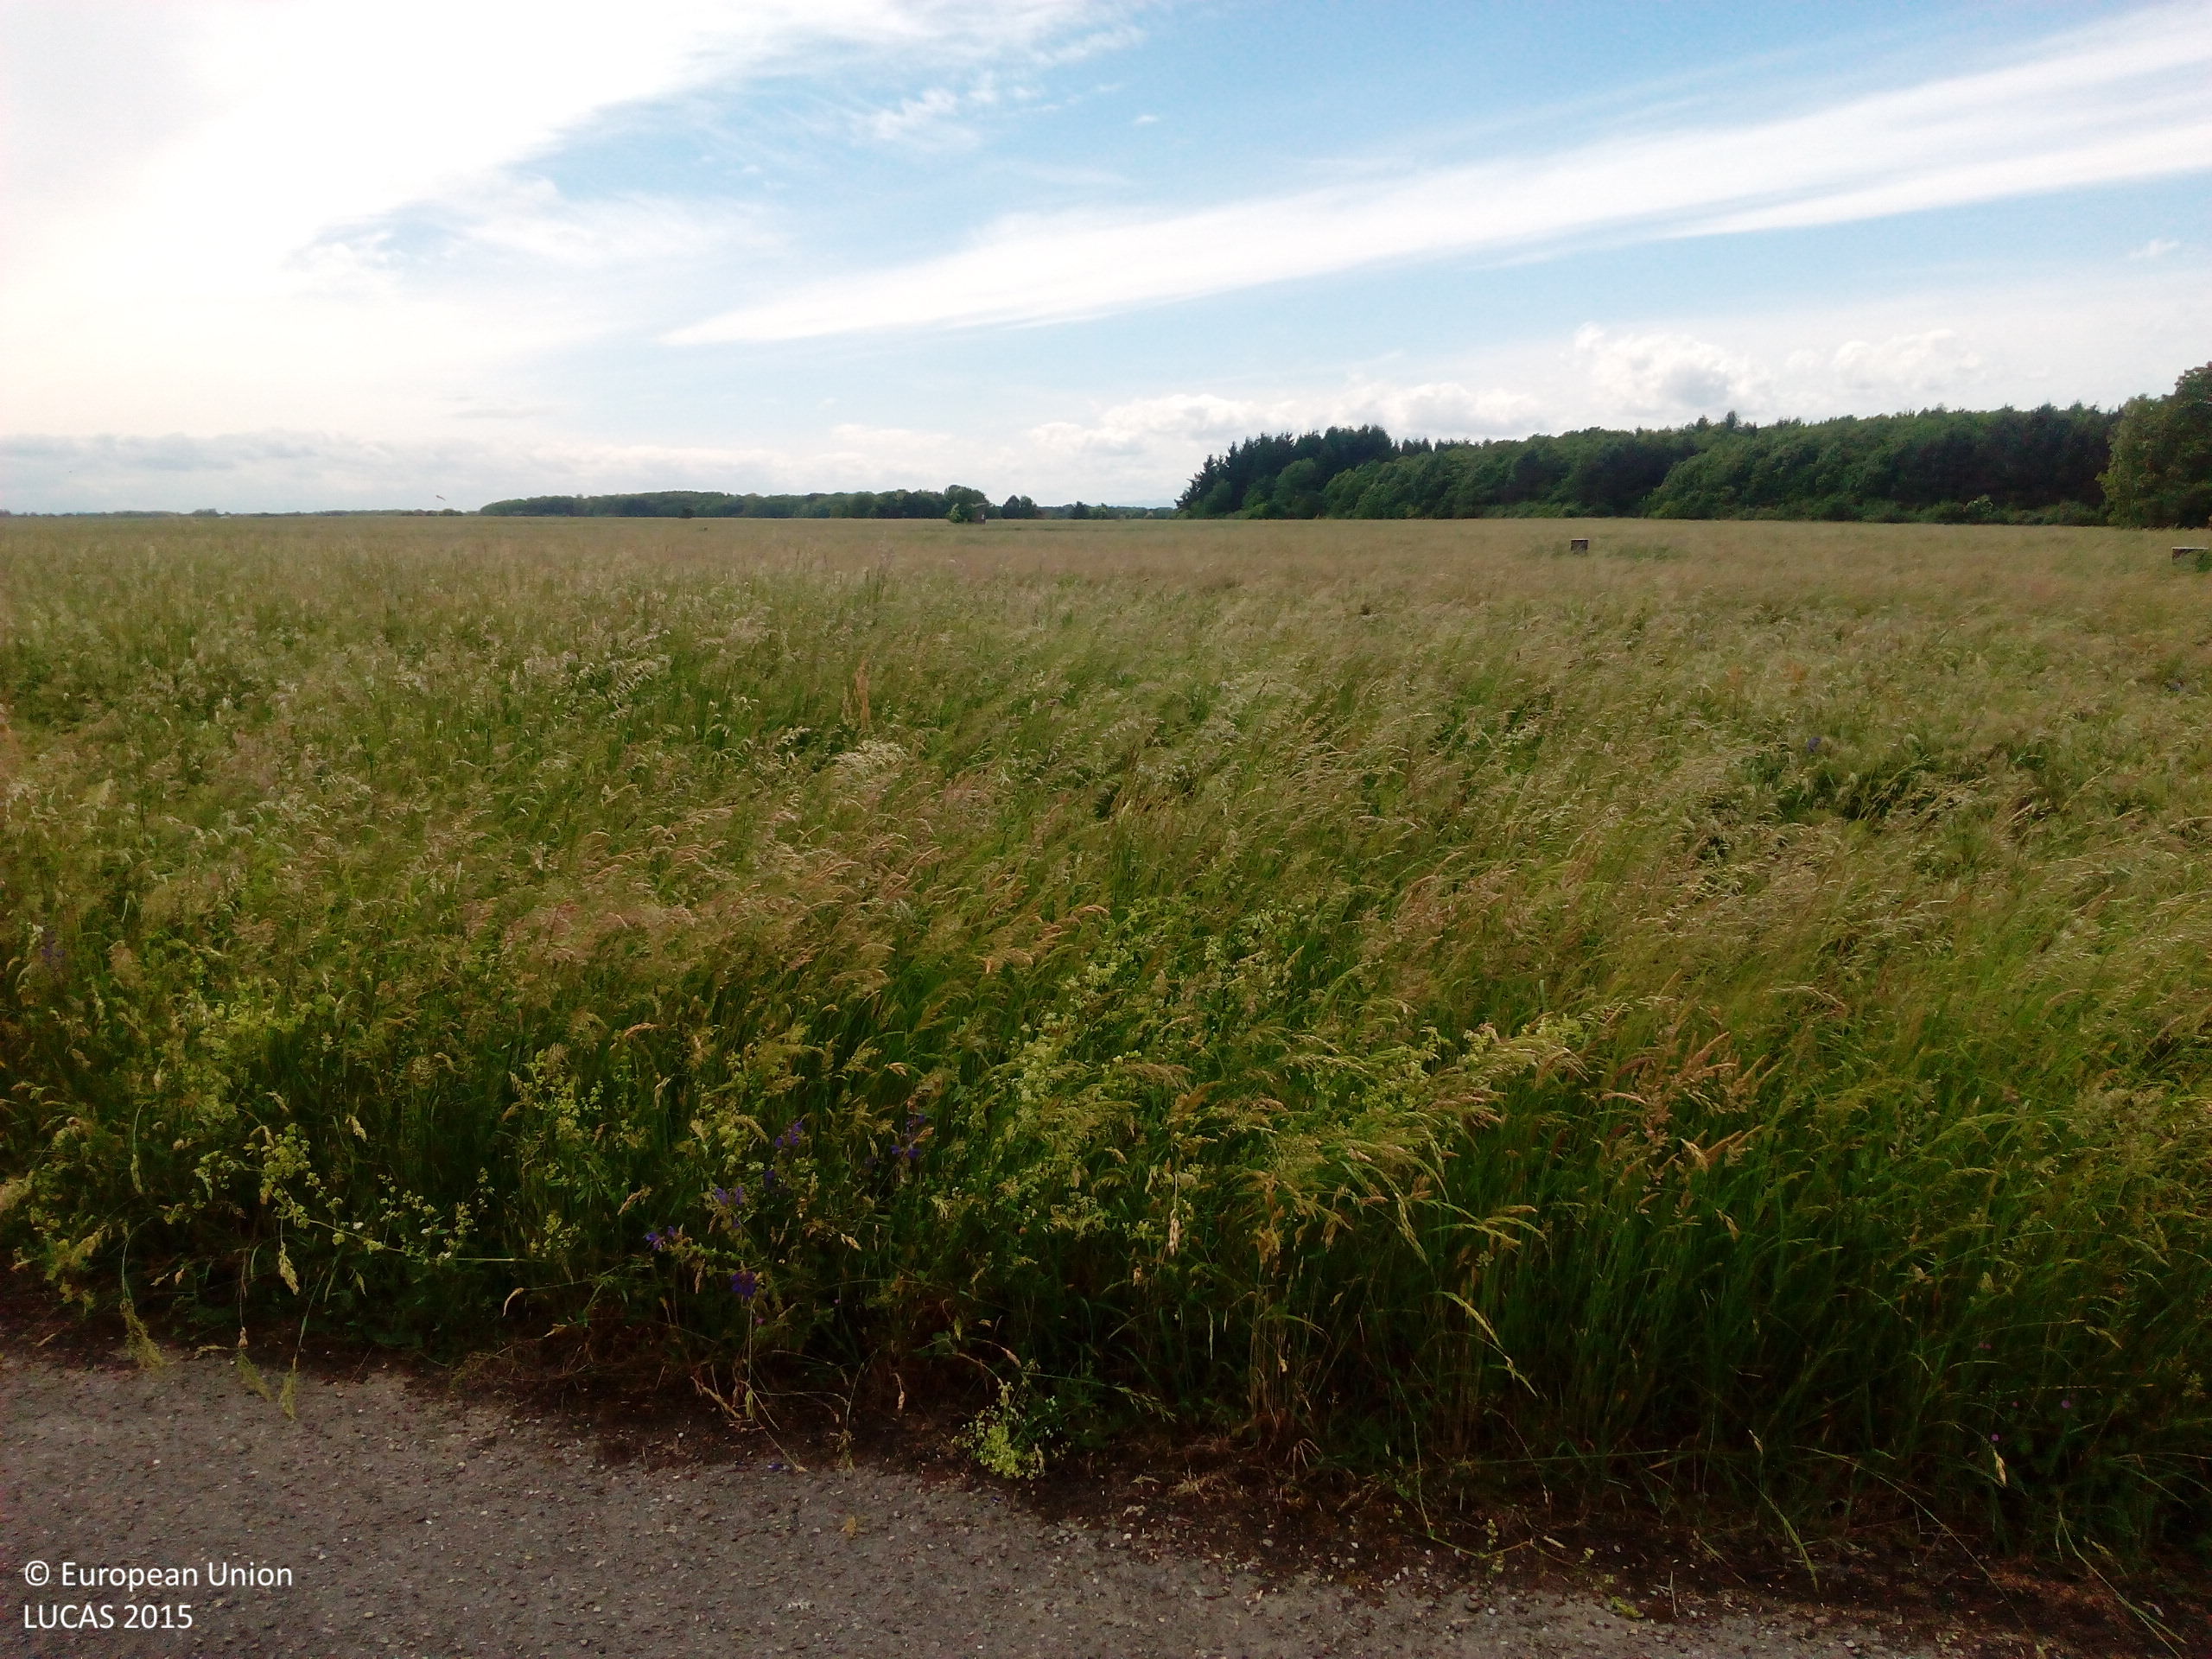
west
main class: Grassland
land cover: Grassland without tree/shrub cover
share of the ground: > 75 %
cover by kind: herbaceous plants 100 %
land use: Air transport
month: May
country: DE
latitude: 47.9101
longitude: 7.6331
